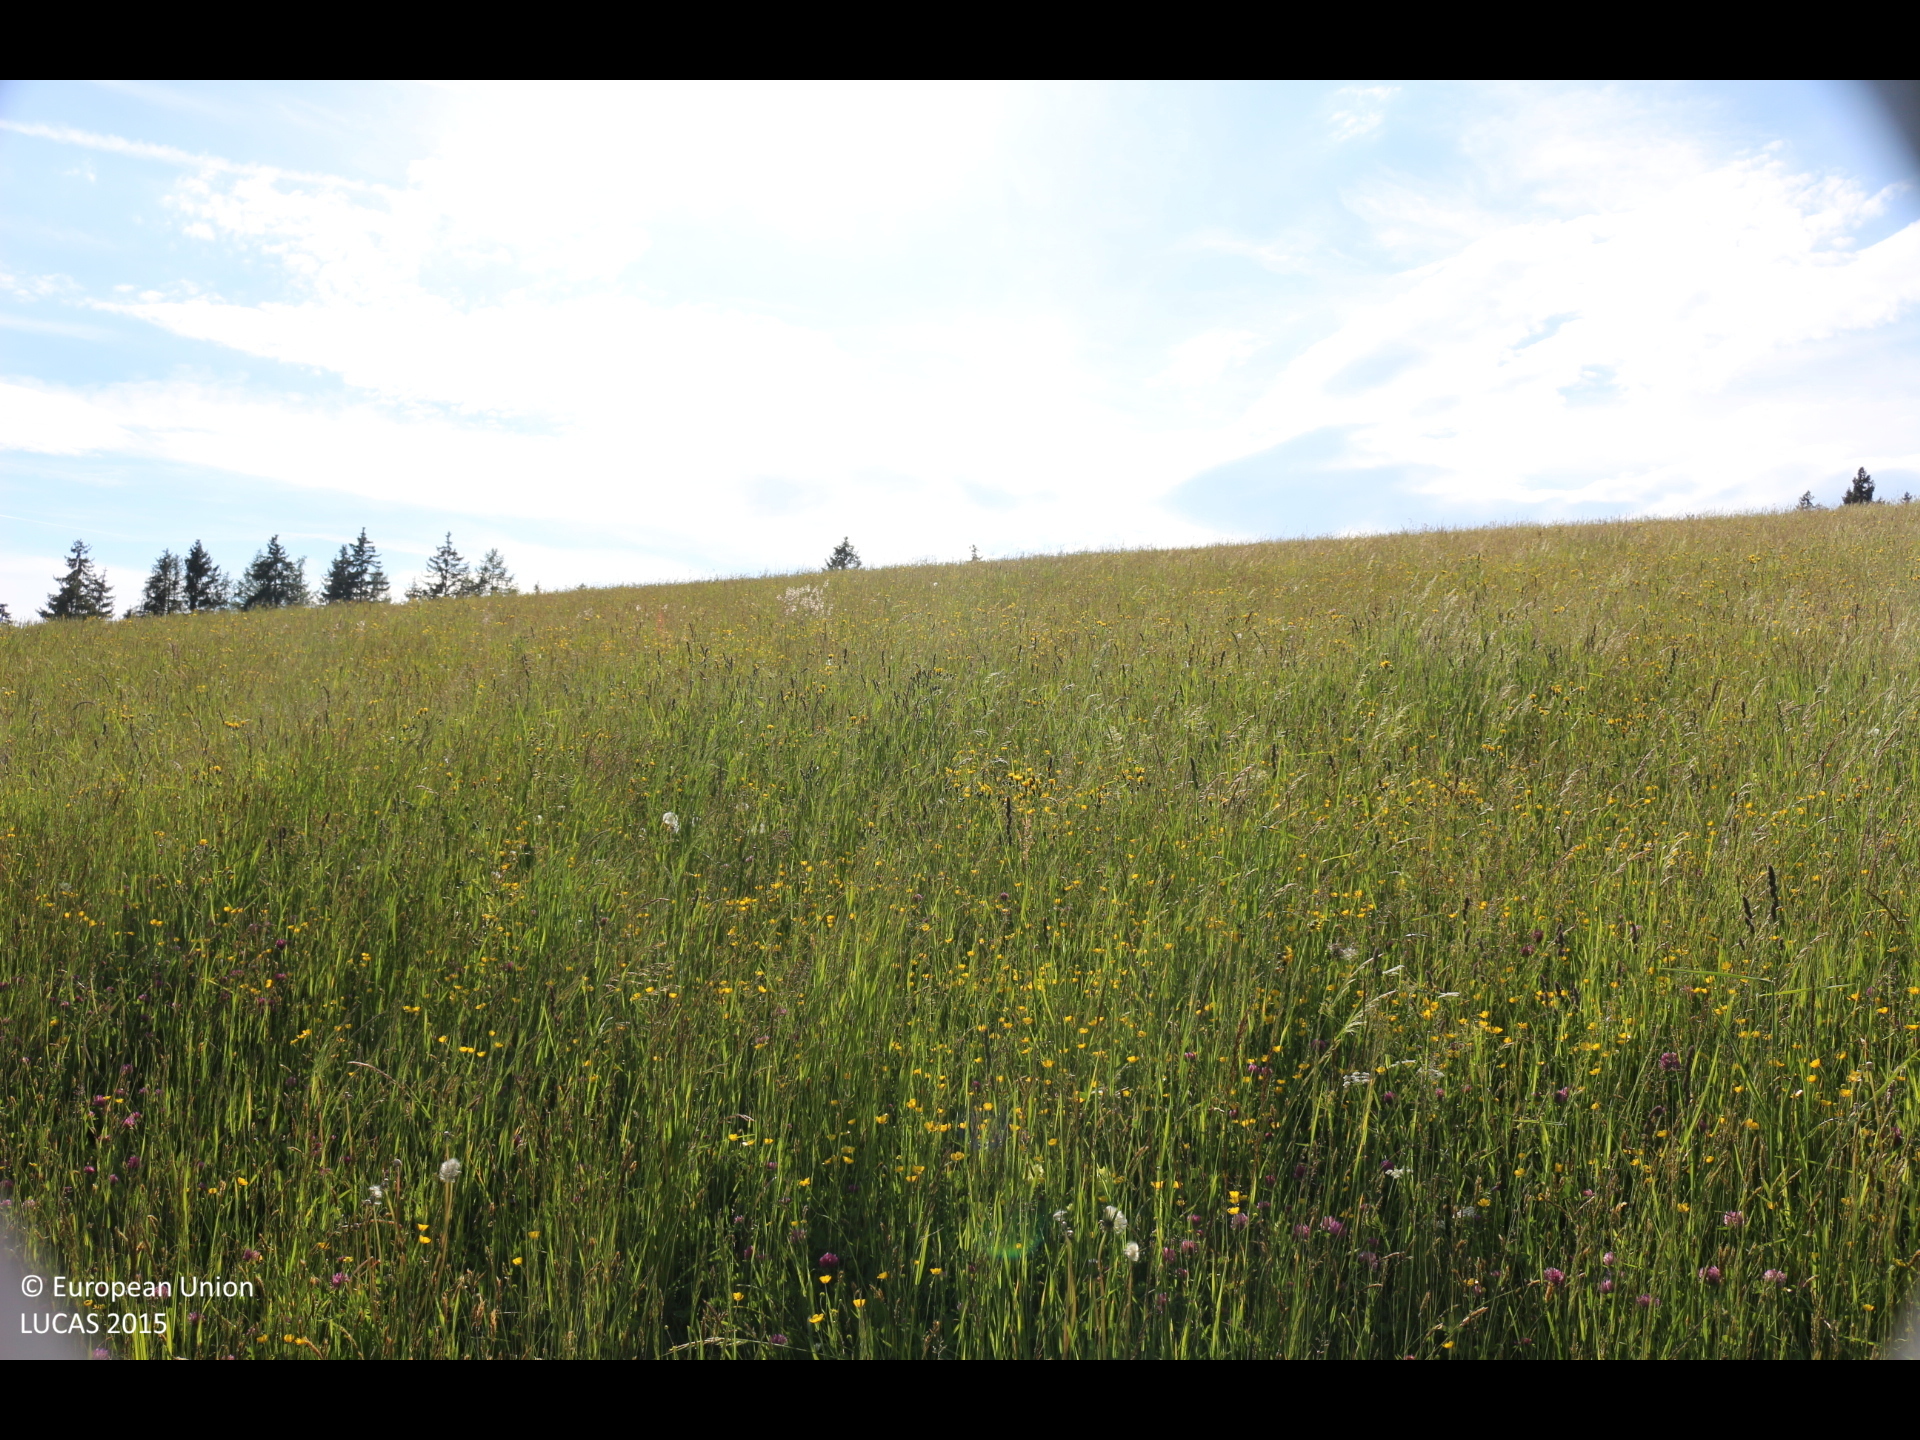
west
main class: Grassland
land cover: Grassland without tree/shrub cover
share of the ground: > 75 %
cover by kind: herbaceous plants 100 %
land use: Agriculture (excluding fallow land and kitchen gardens)
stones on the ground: < 10 %
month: May
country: AT
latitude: 46.7576
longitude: 14.5933
